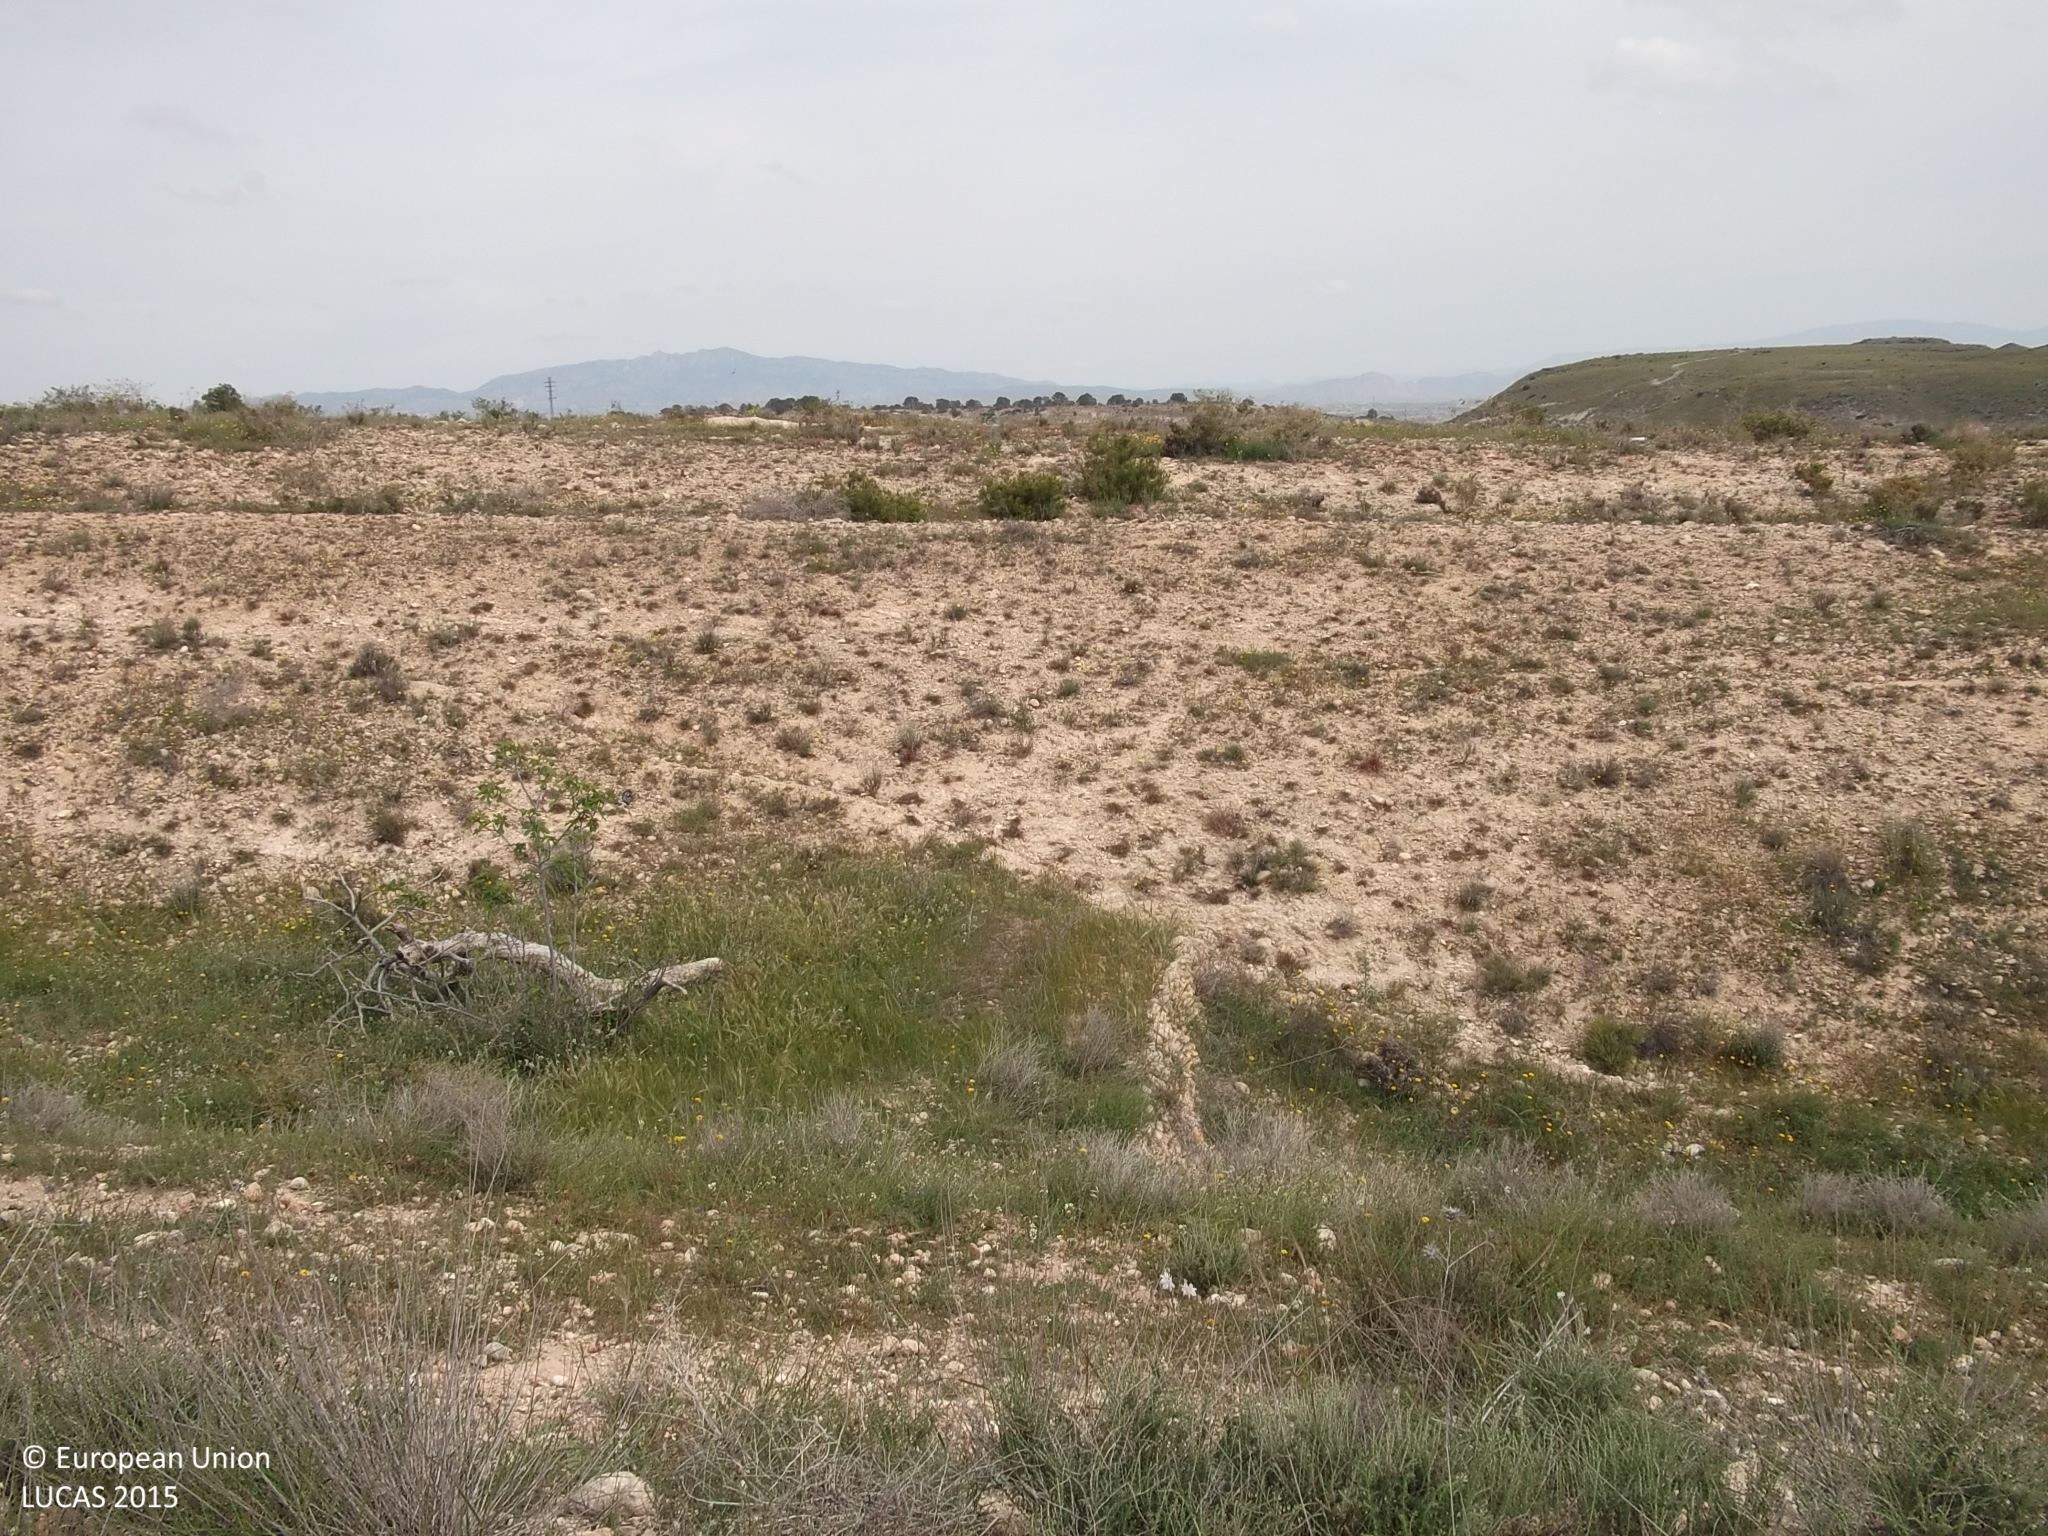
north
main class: Shrubland
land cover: Shrubland without tree cover
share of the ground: 25 - 50 %
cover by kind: herbaceous plants 40 %, shrubs 30 %, consolidated bare surface 30 %
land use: Semi-natural and natural areas not in use
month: April
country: ES
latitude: 37.9408
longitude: -1.3746
